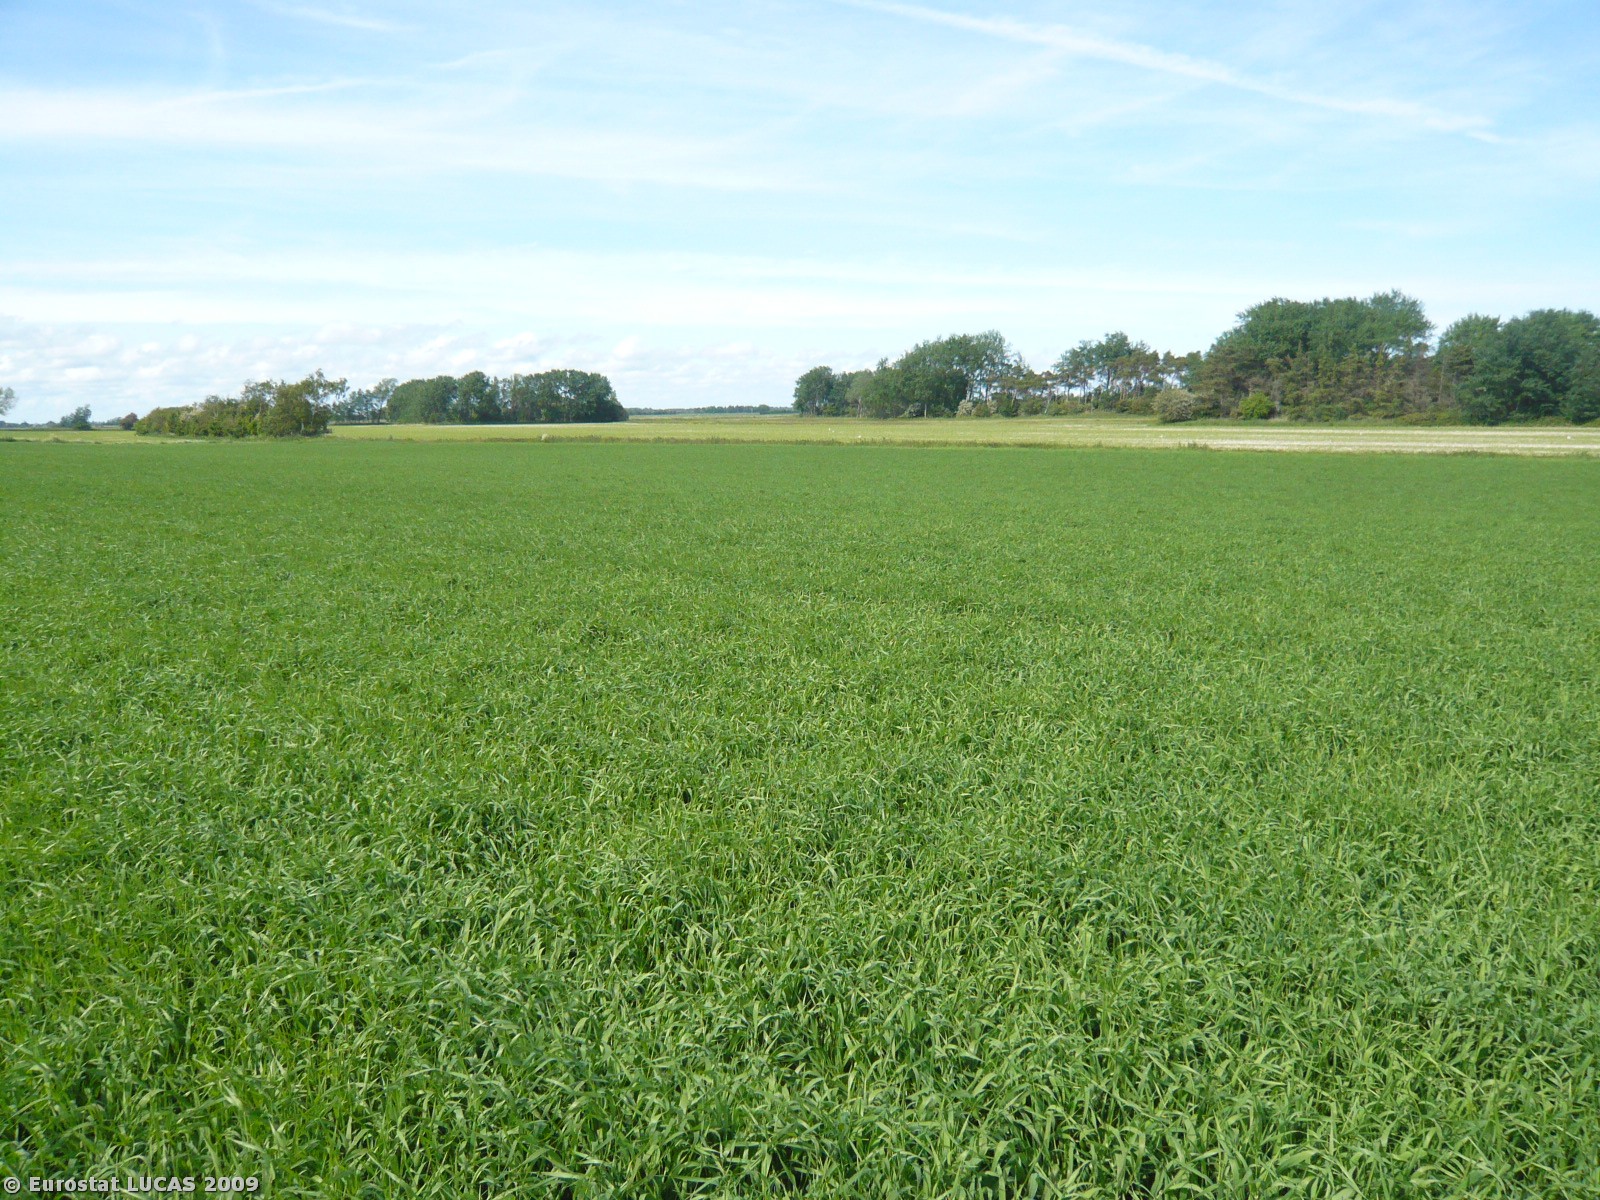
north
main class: Cropland
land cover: Barley
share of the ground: > 75 %
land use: Agriculture (excluding fallow land and kitchen gardens)
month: June
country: DK
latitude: 54.6090
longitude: 11.9342
